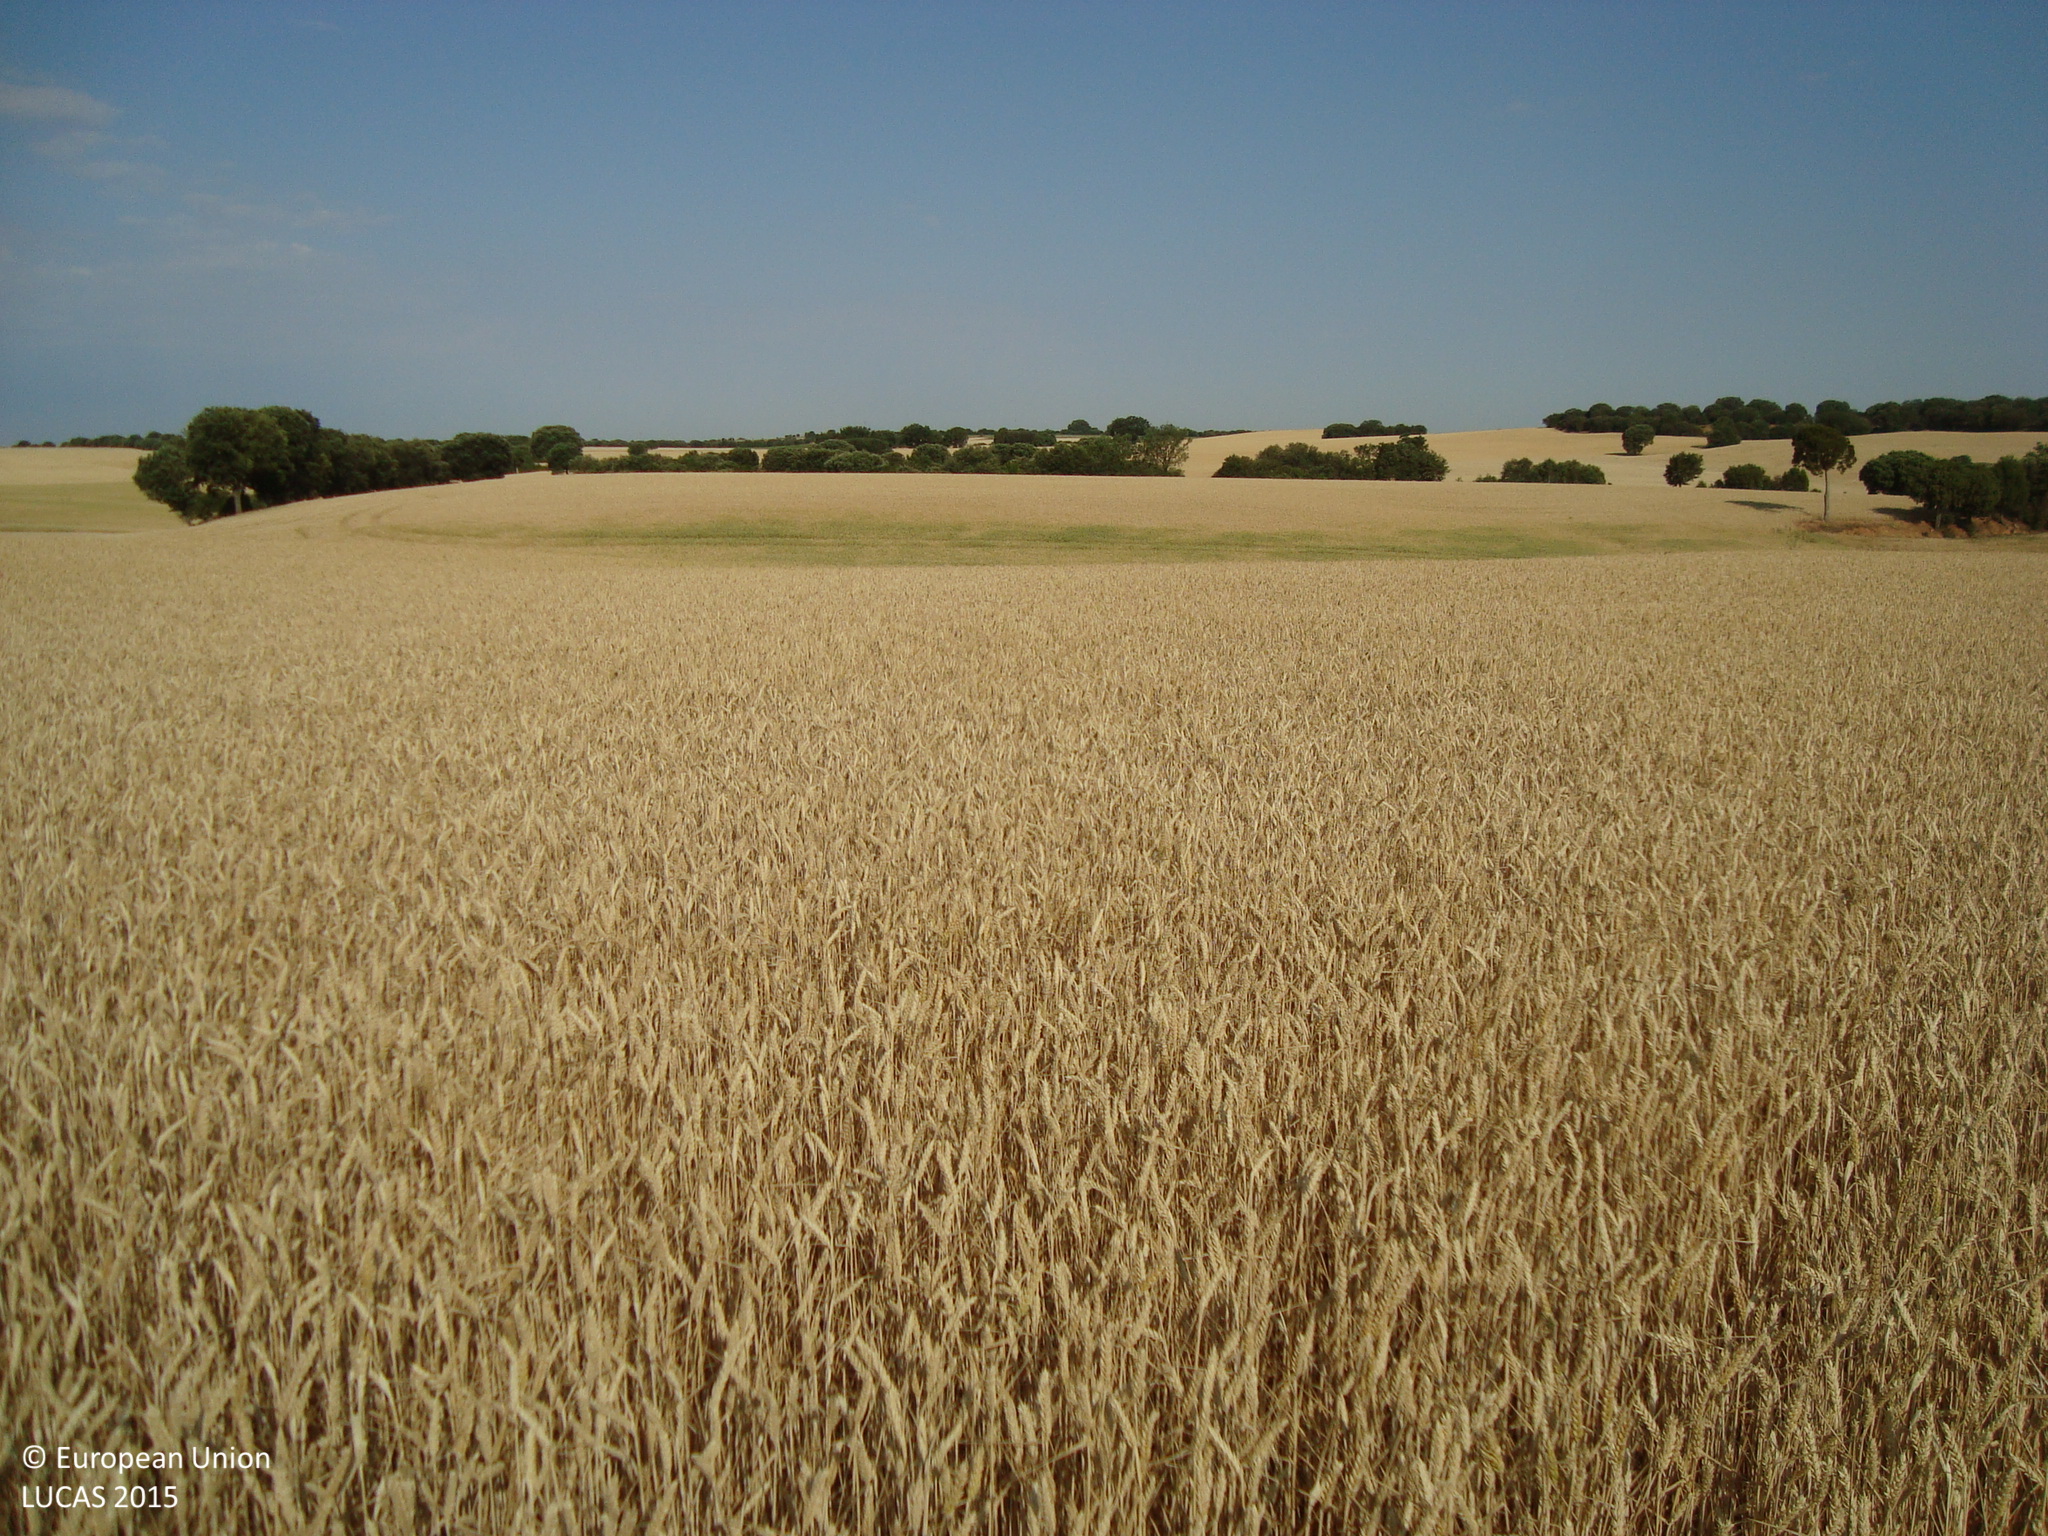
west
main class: Cropland
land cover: Common wheat
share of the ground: > 75 %
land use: Agriculture (excluding fallow land and kitchen gardens)
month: June
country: ES
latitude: 41.9815
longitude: -3.7805
